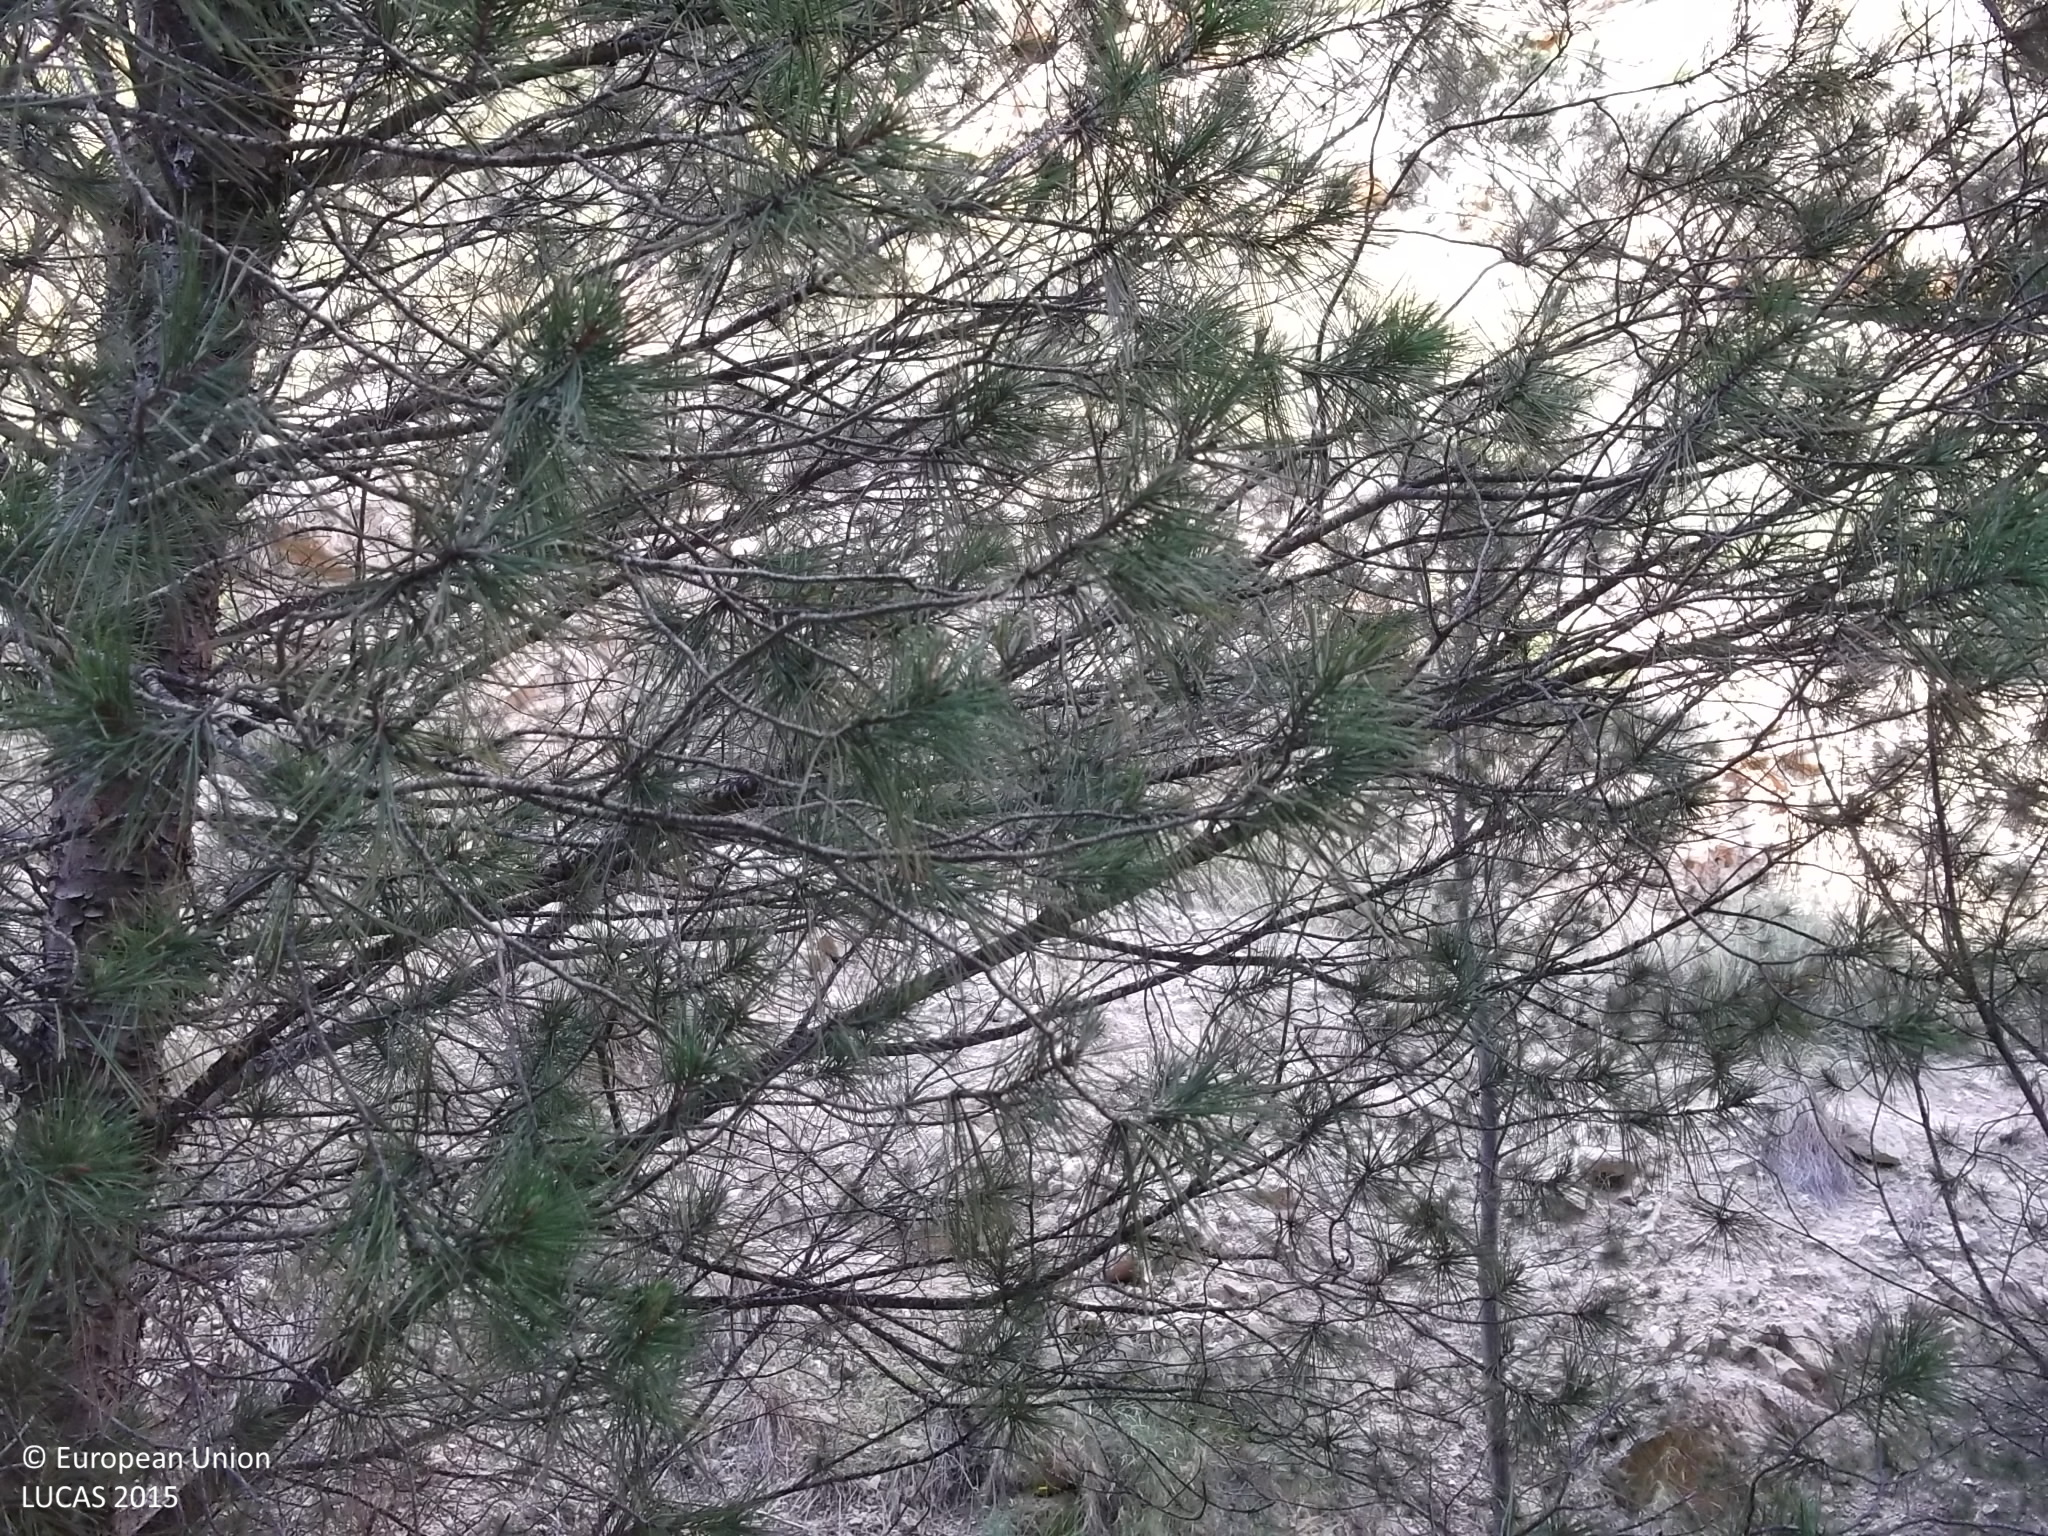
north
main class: Woodland
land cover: Pine dominated coniferous woodland
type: coniferous forest of the mediterranean region
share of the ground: 25 - 50 %
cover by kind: herbaceous plants 50 %, coniferous forest trees 25 %, shrubs 25 %
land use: Semi-natural and natural areas not in use
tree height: > 5 m
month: April
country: ES
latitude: 38.1487
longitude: -1.3179
